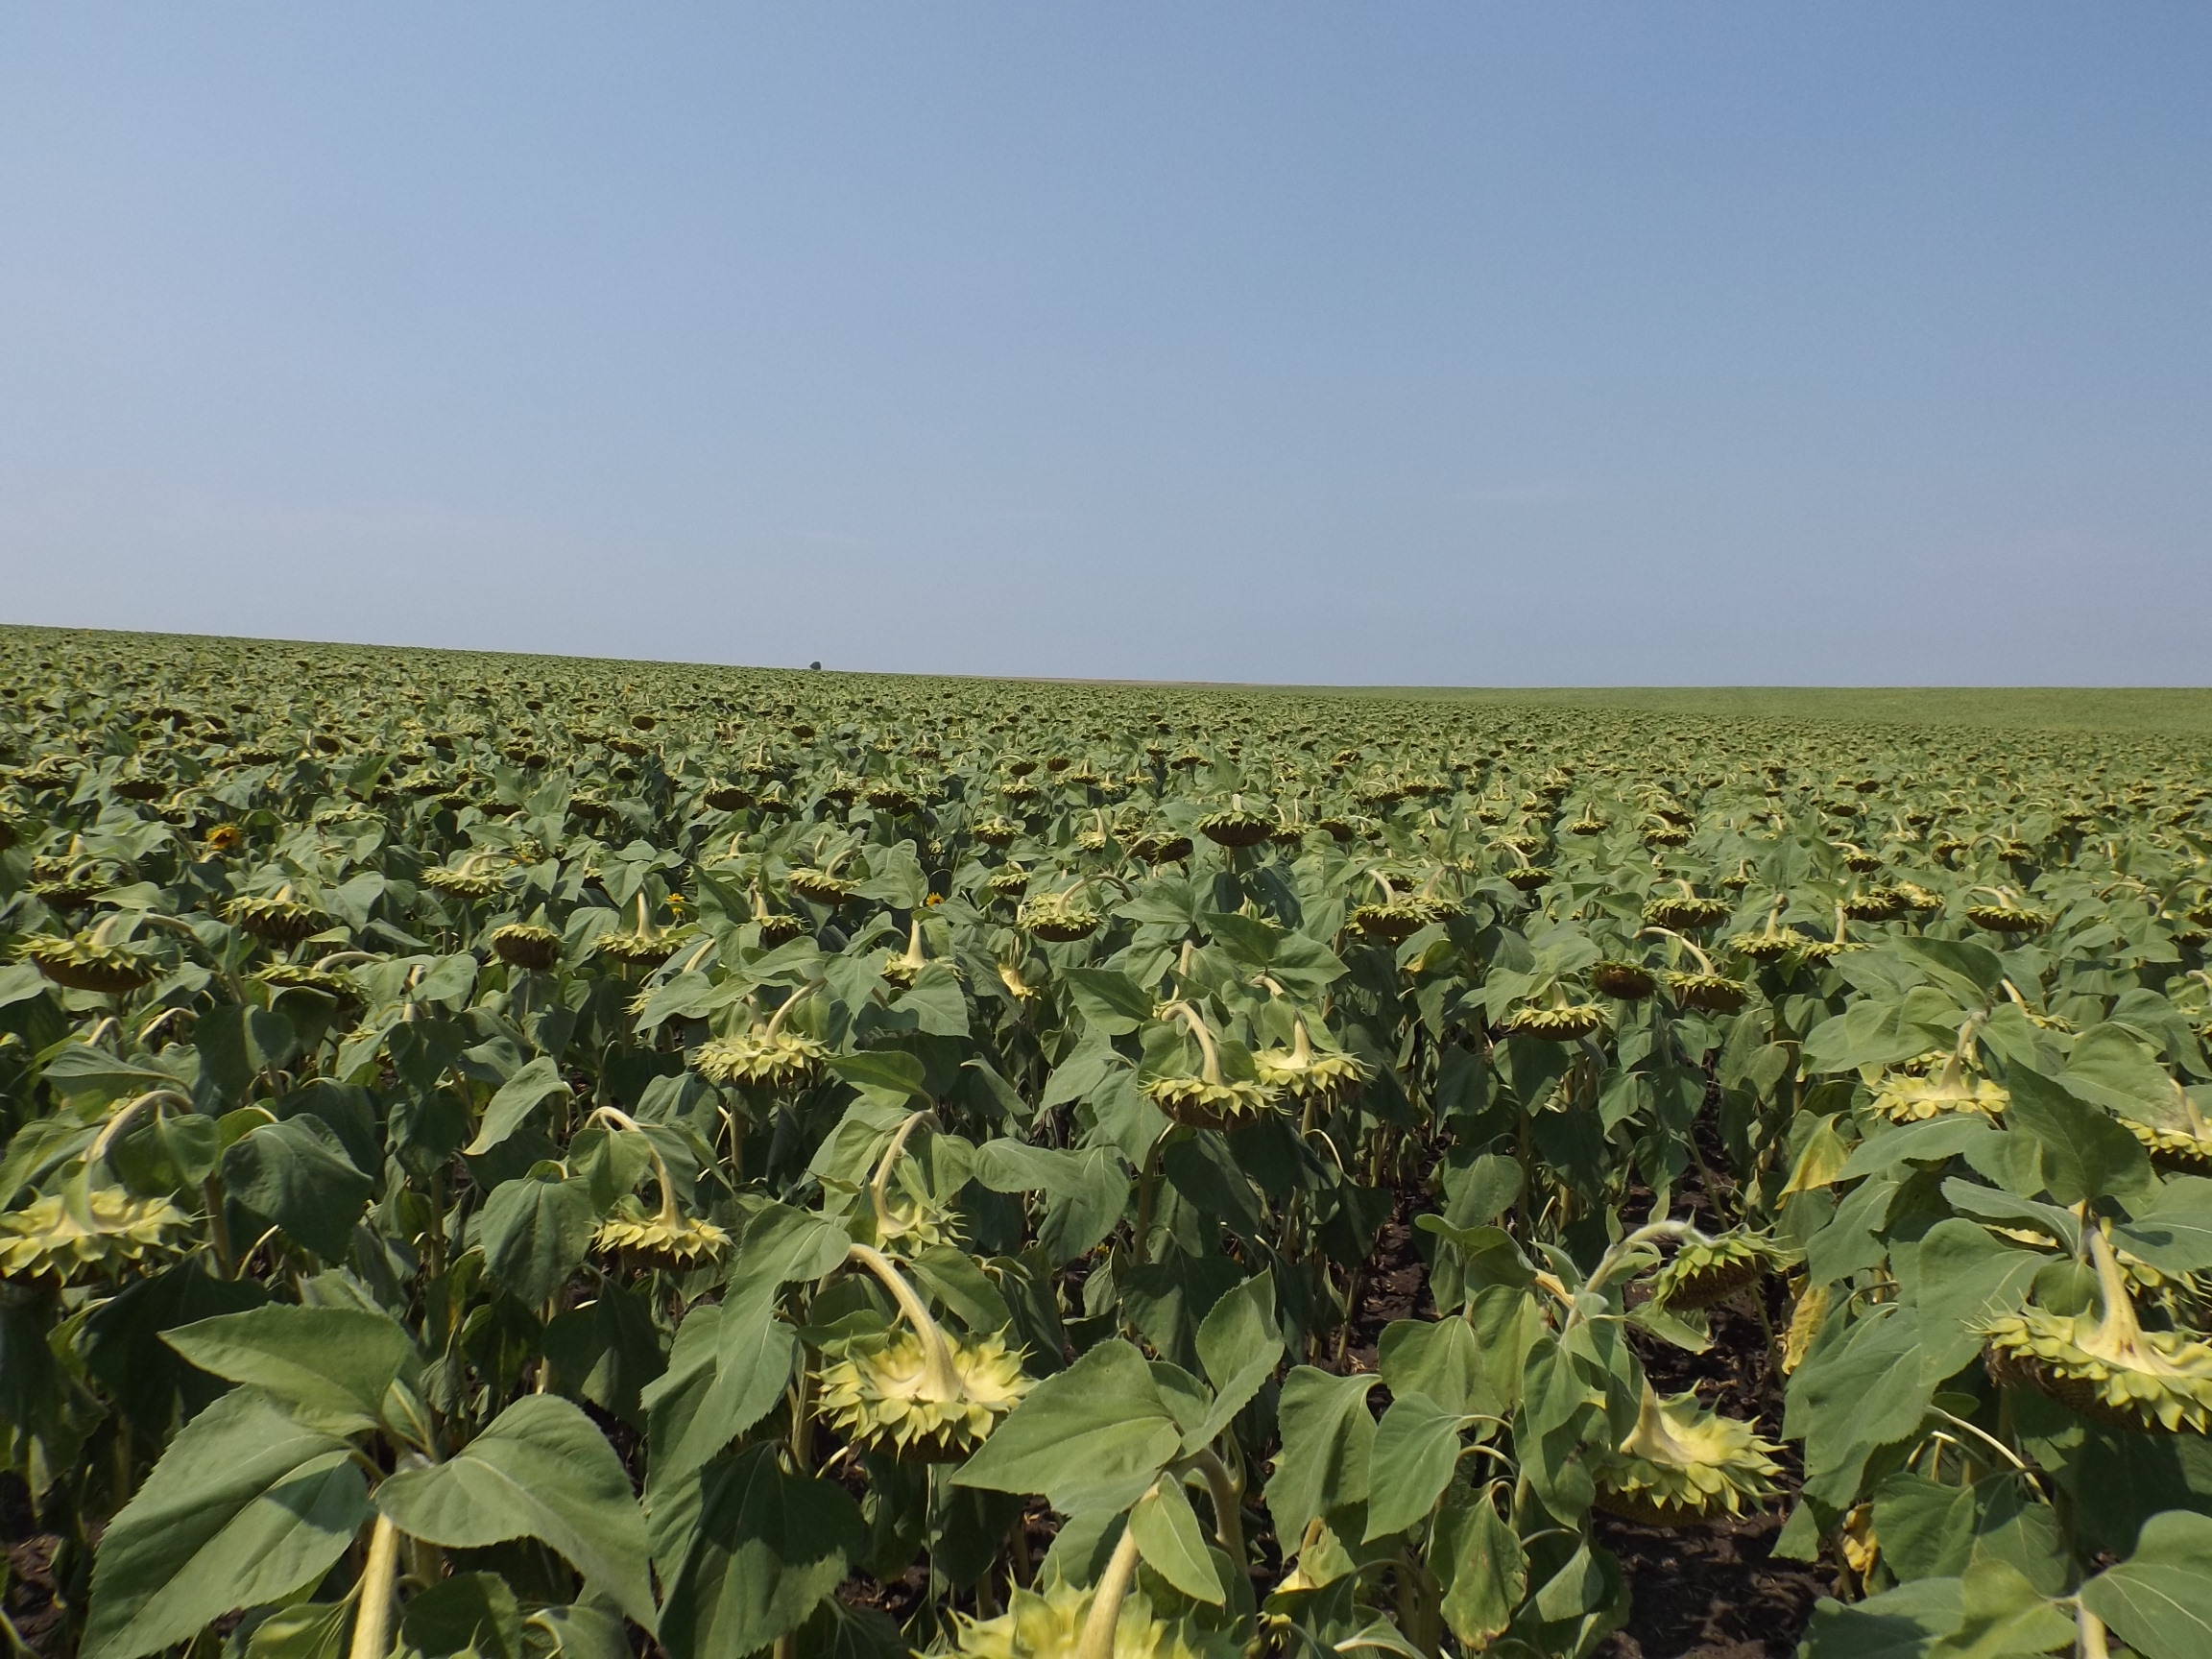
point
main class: Cropland
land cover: Sunflower
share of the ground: > 75 %
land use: Agriculture (excluding fallow land and kitchen gardens)
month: July
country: BG
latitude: 43.4623
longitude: 27.4705
